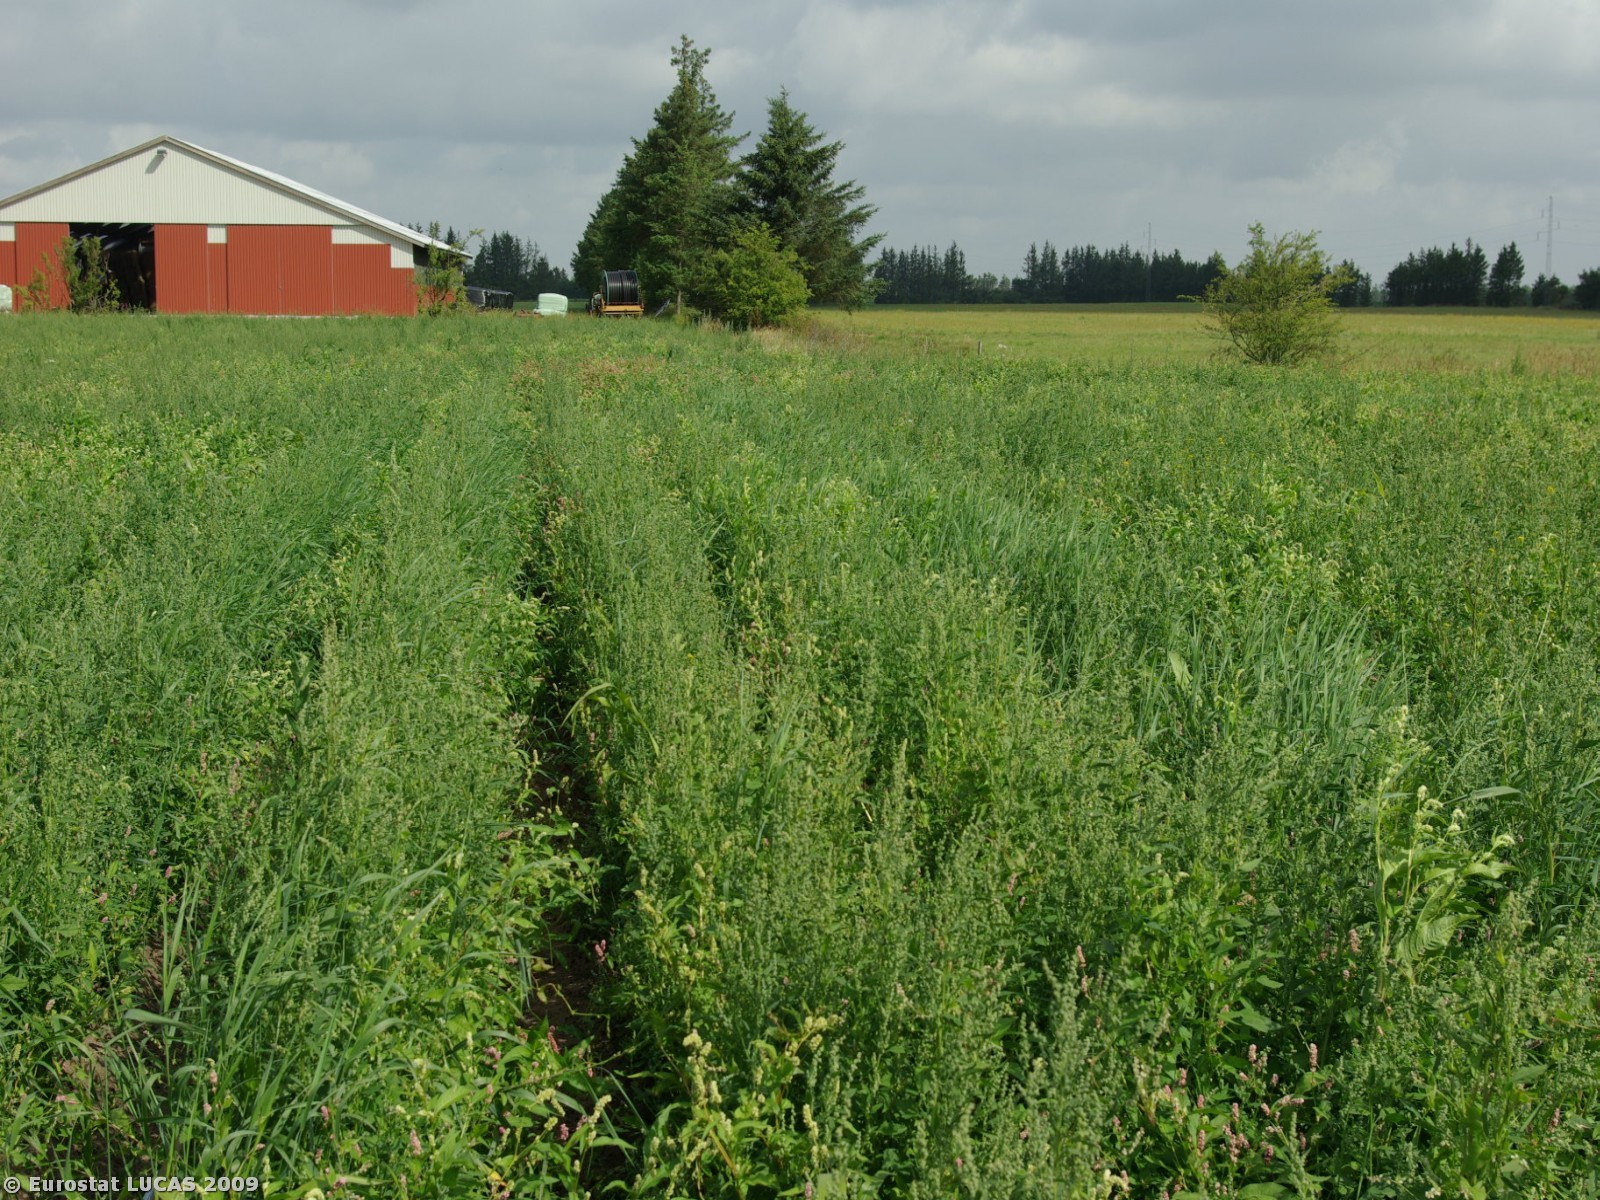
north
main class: Cropland
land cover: Maize
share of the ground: 10 - 25 %
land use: Agriculture (excluding fallow land and kitchen gardens)
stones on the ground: < 10 %
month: July
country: DK
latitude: 54.9096
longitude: 9.2986
